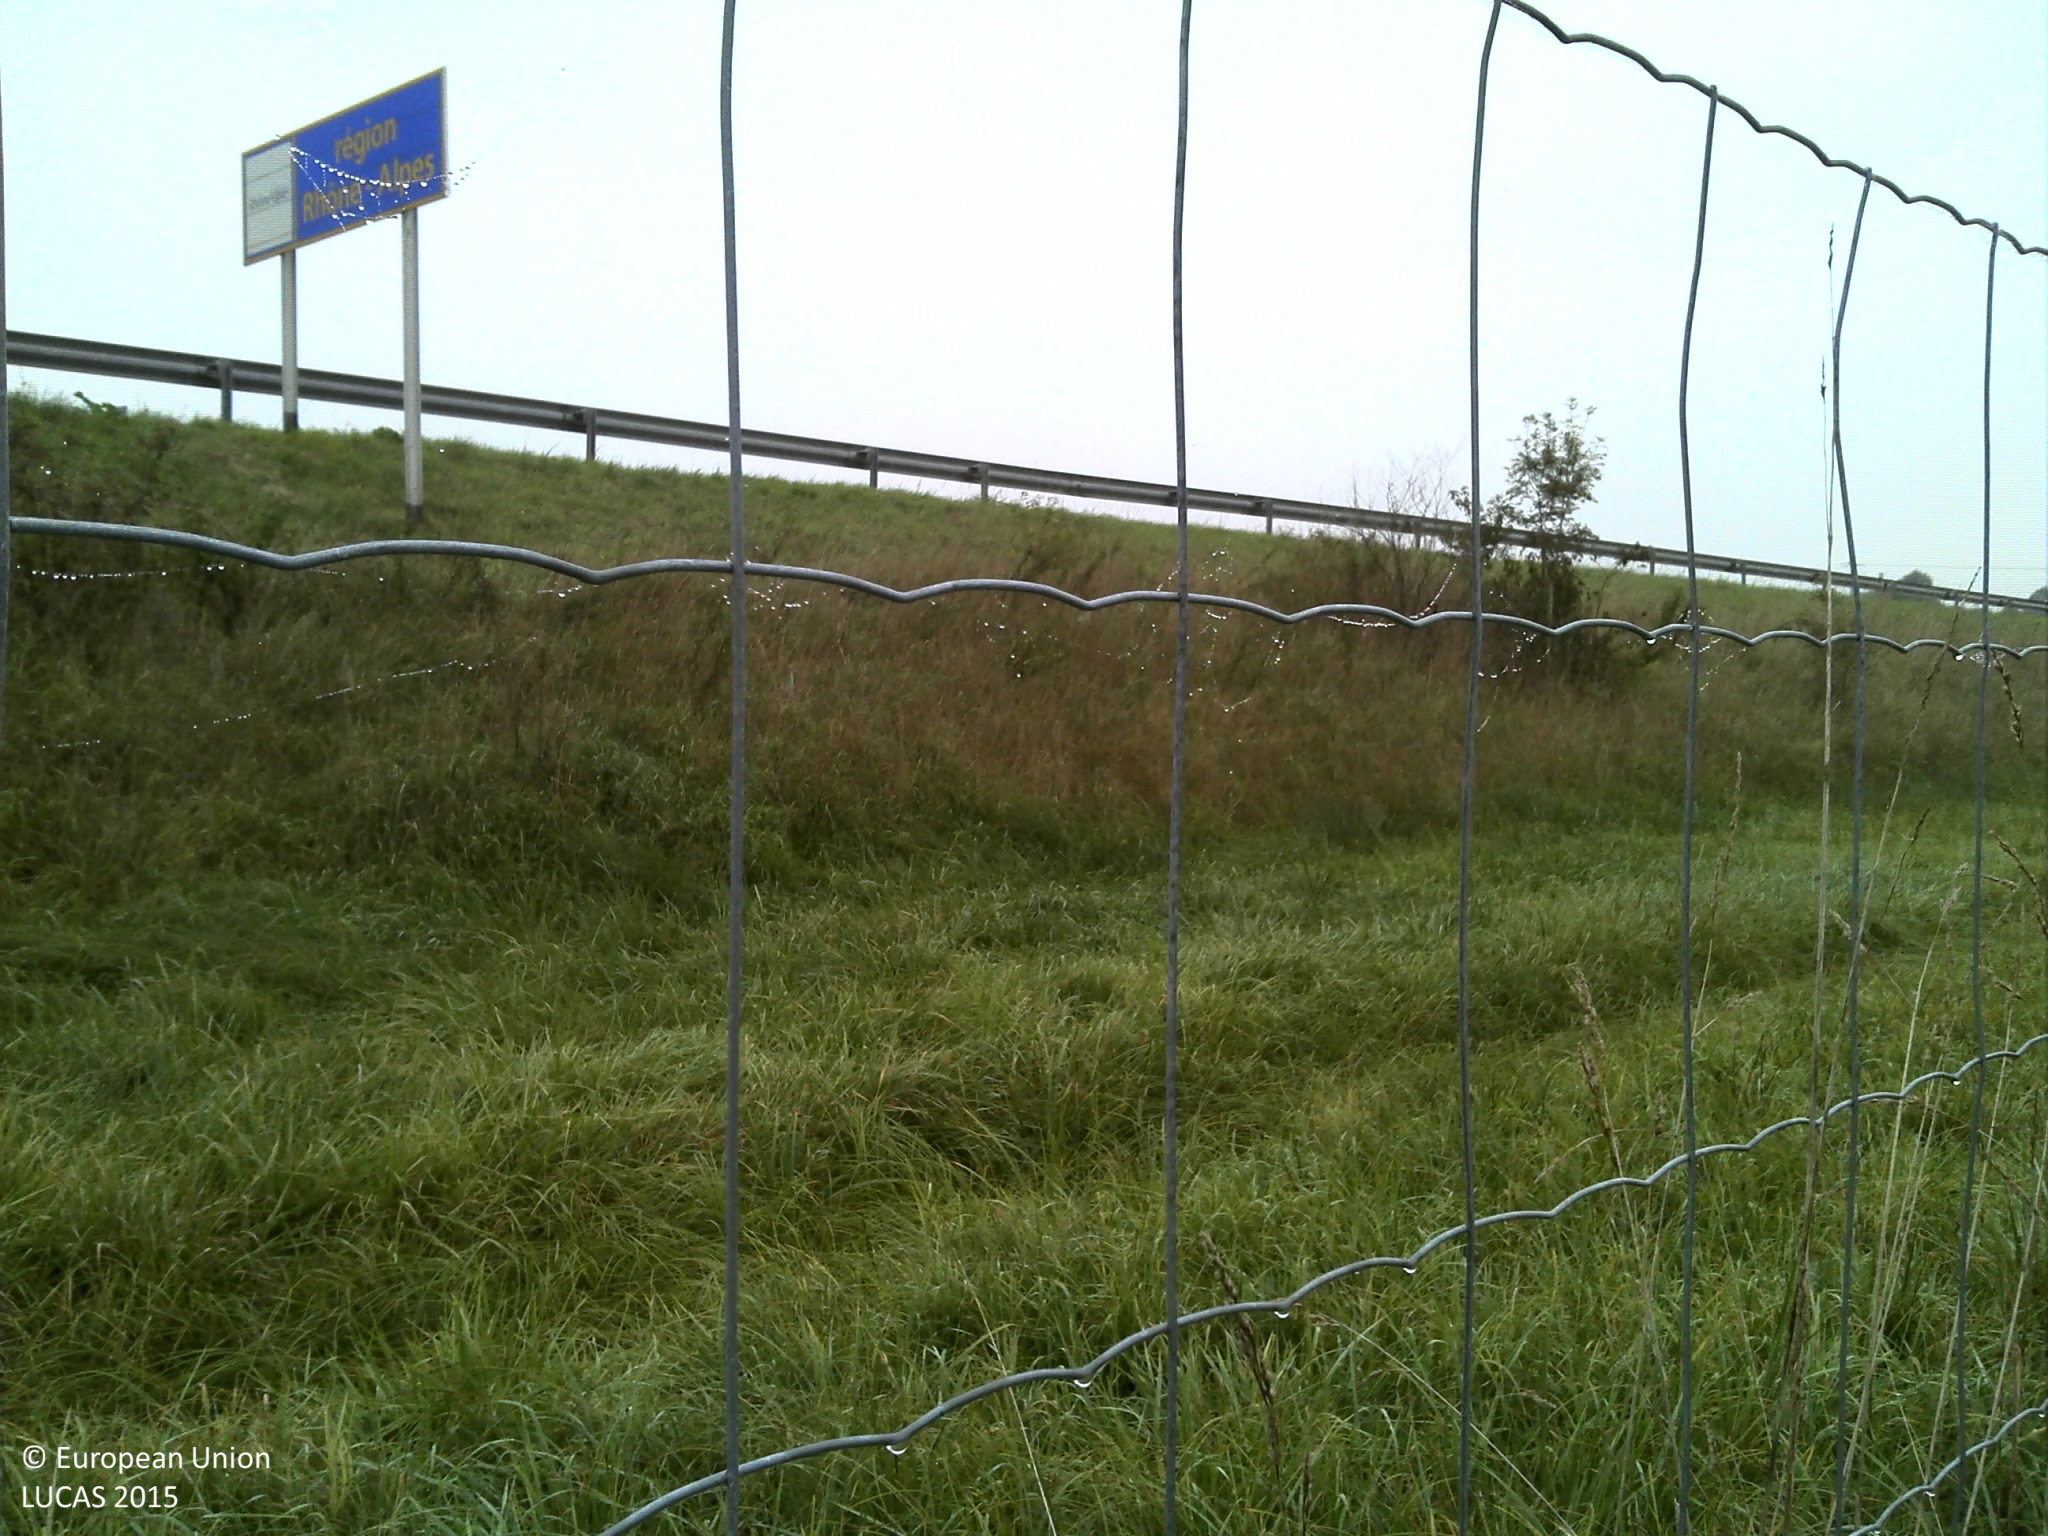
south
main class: Grassland
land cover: Grassland without tree/shrub cover
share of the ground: > 75 %
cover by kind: herbaceous plants 100 %
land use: Road transport
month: October
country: FR
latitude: 46.4454
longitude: 5.2773
